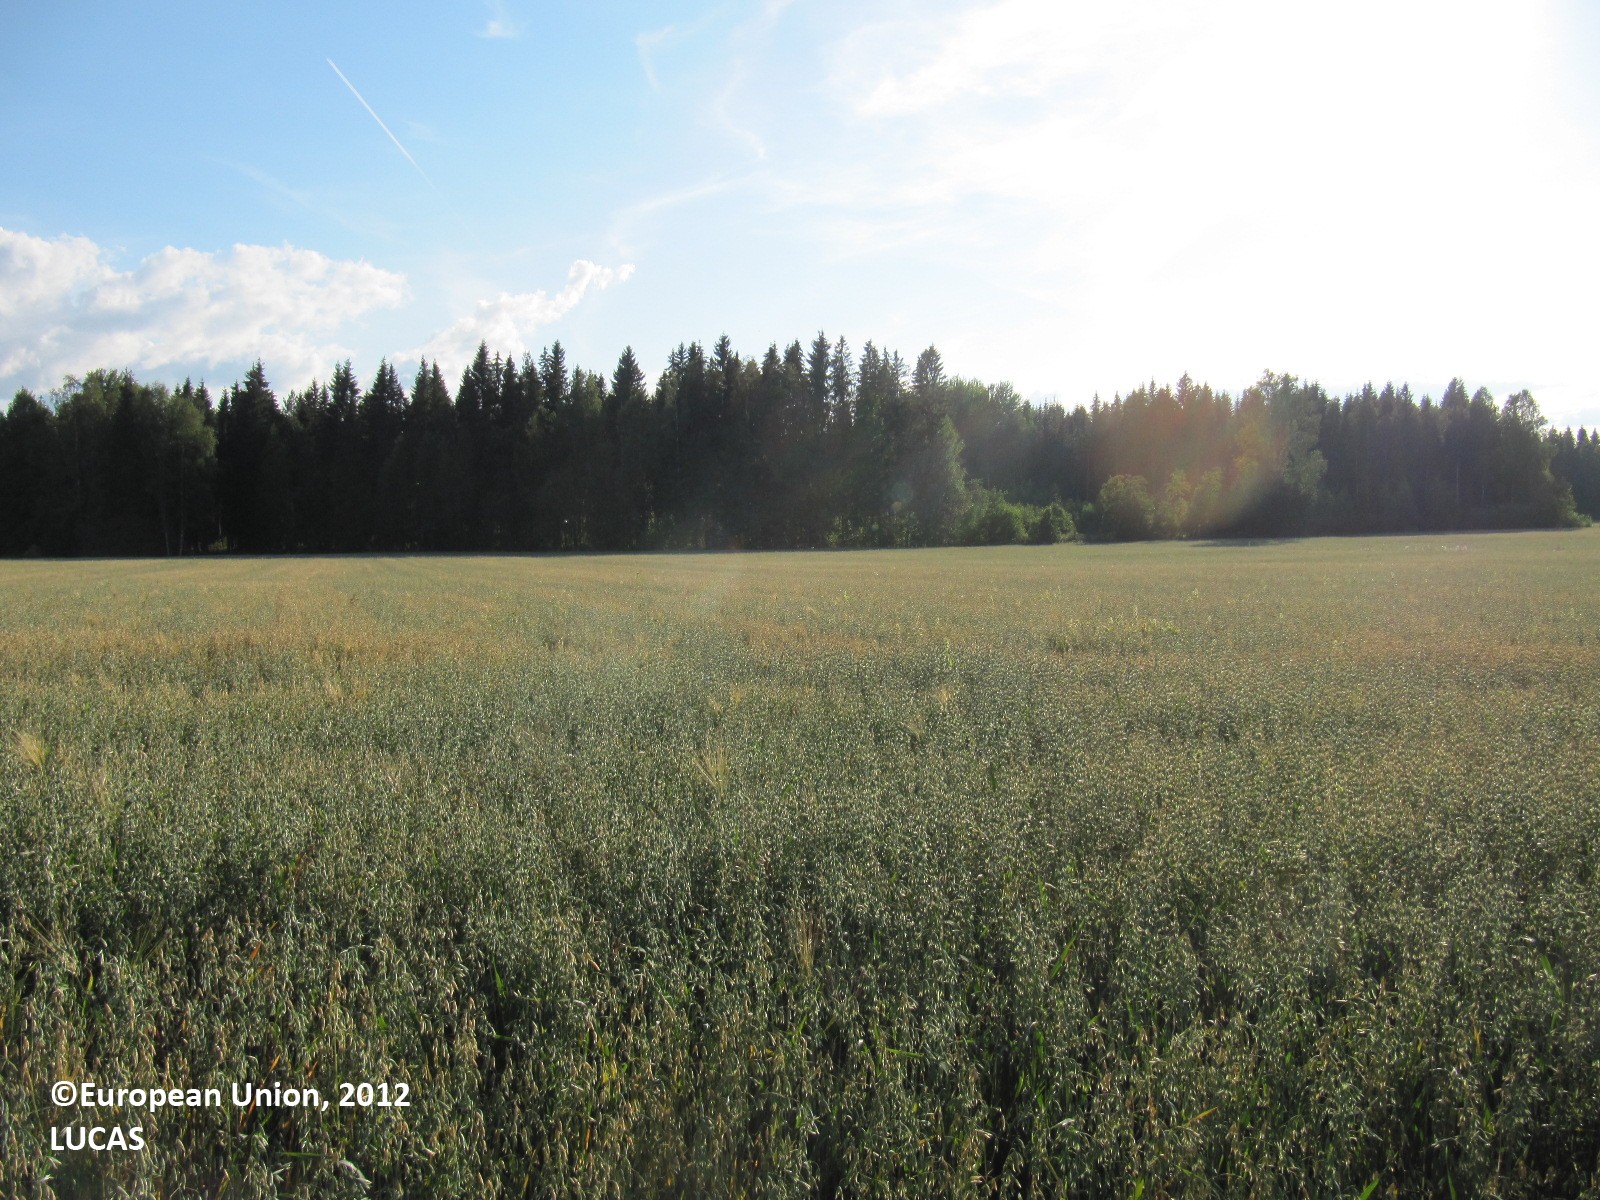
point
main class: Cropland
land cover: Oats
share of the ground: > 75 %
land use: Agriculture (excluding fallow land and kitchen gardens)
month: August
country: FI
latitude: 60.5499
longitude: 24.4548
